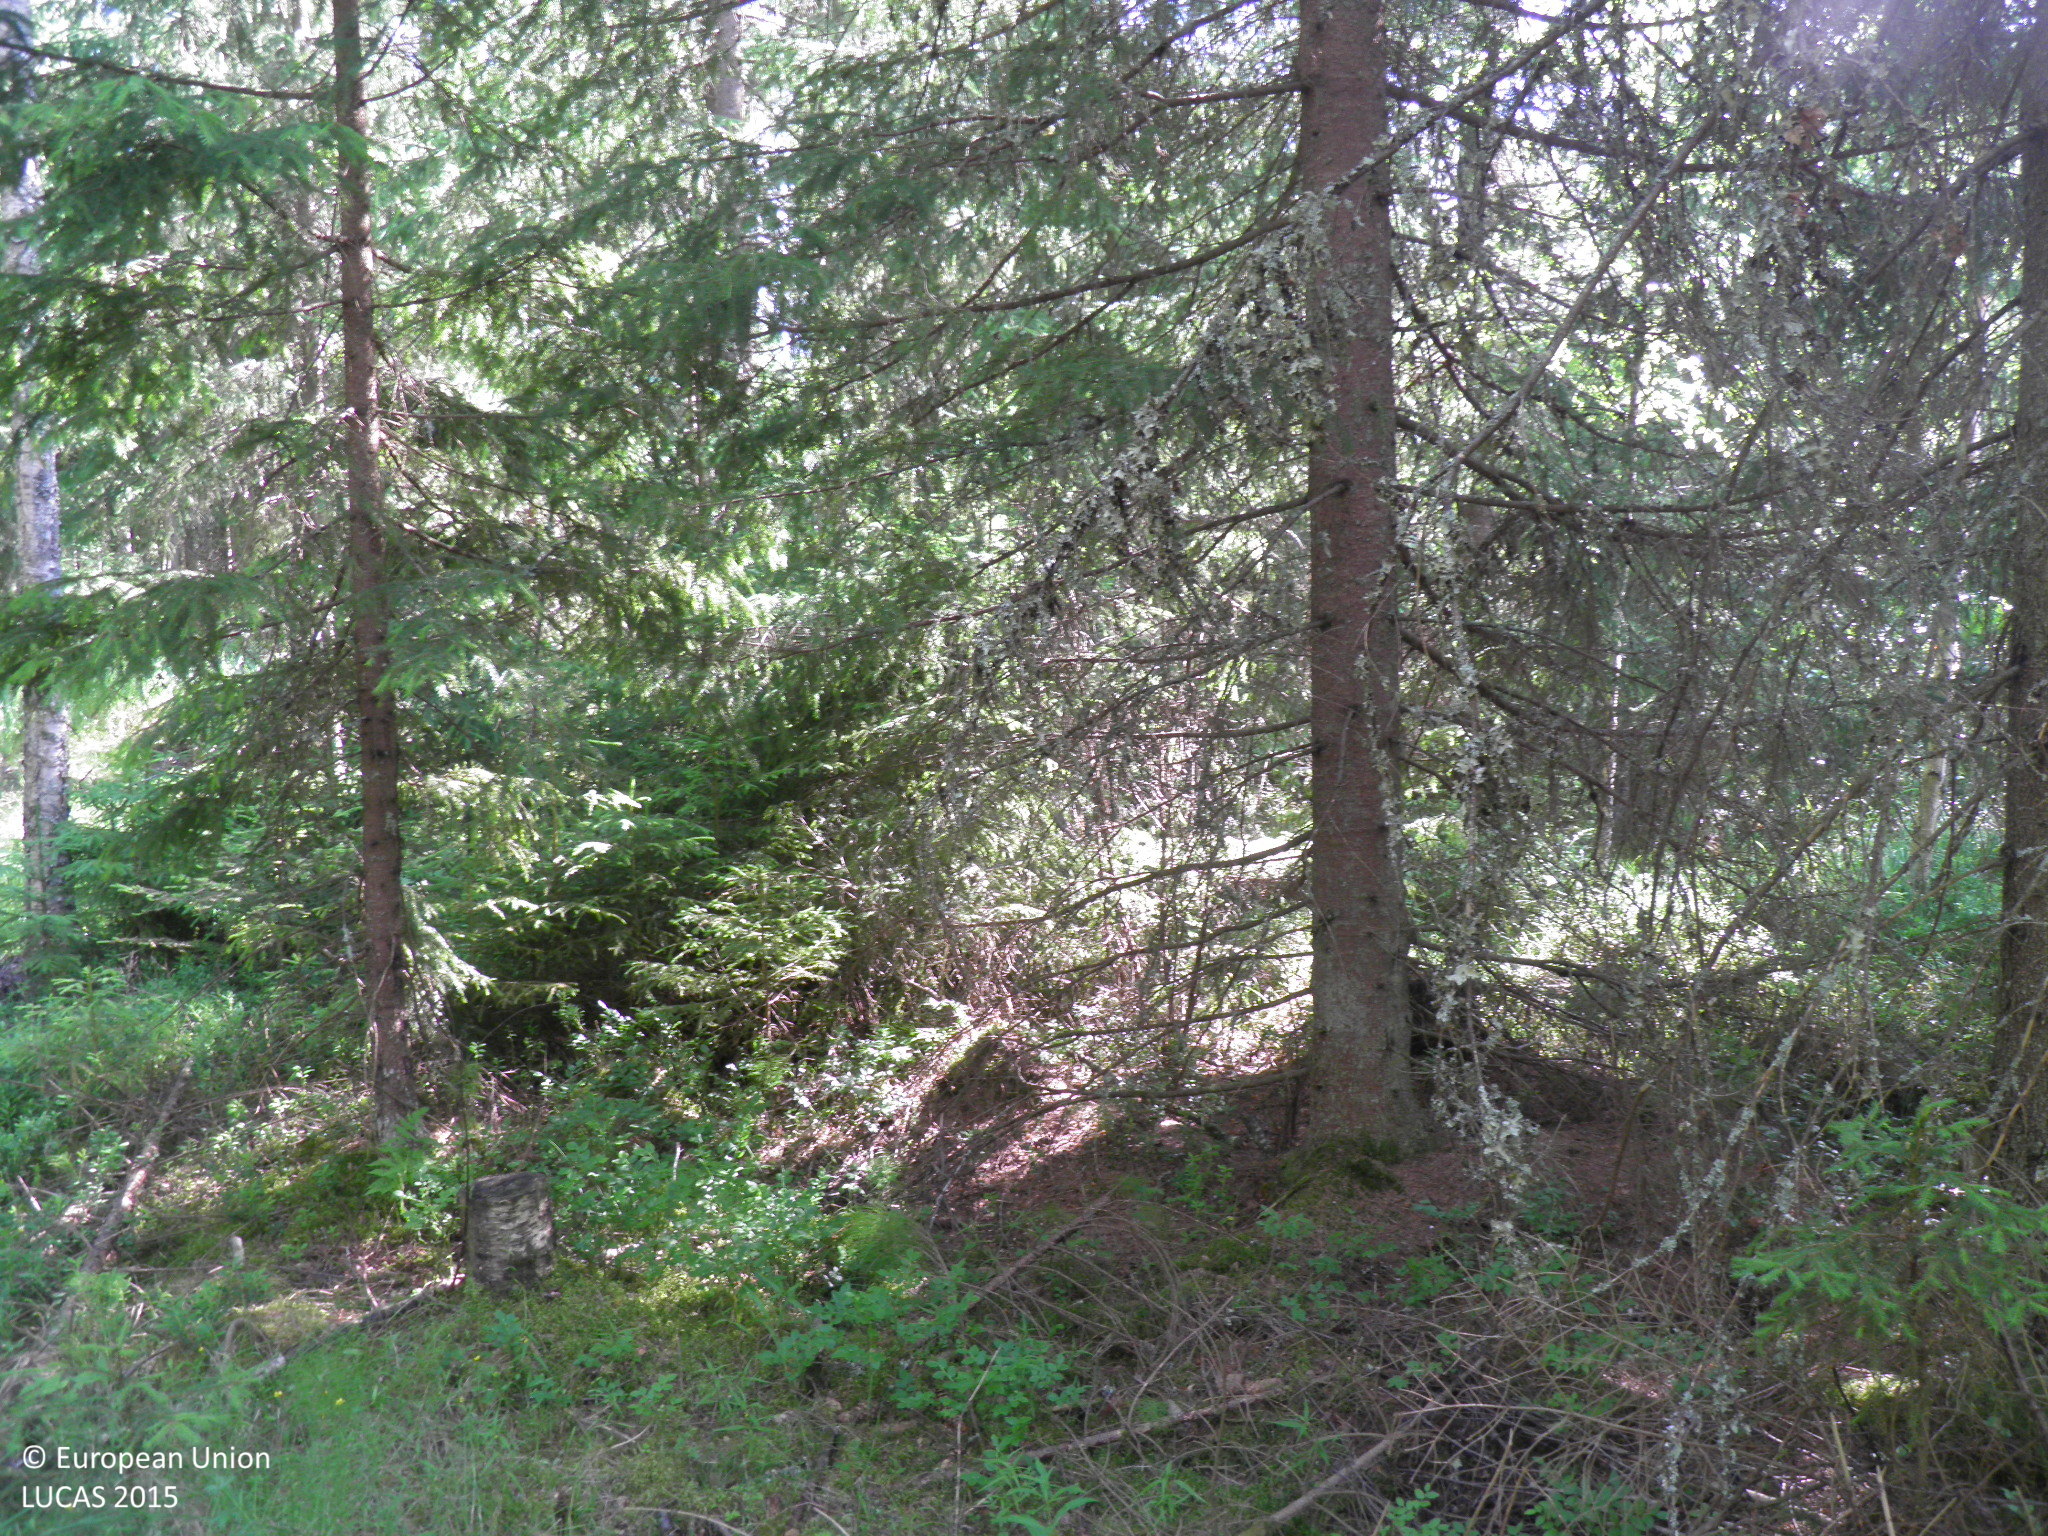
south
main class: Woodland
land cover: Spruce dominated mixed woodland
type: hemiboreal forest and nemoral coniferous forest and mixed broadleaved-coniferous forest
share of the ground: 50 - 75 %
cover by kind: coniferous forest trees 40 %, broadleaved forest trees 30 %, shrubs 10 %, herbaceous plants 10 %, lichens and mosses 10 %
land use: Forestry
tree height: > 5 m
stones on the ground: < 10 %
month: July
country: FI
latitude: 60.6250
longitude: 22.9239
